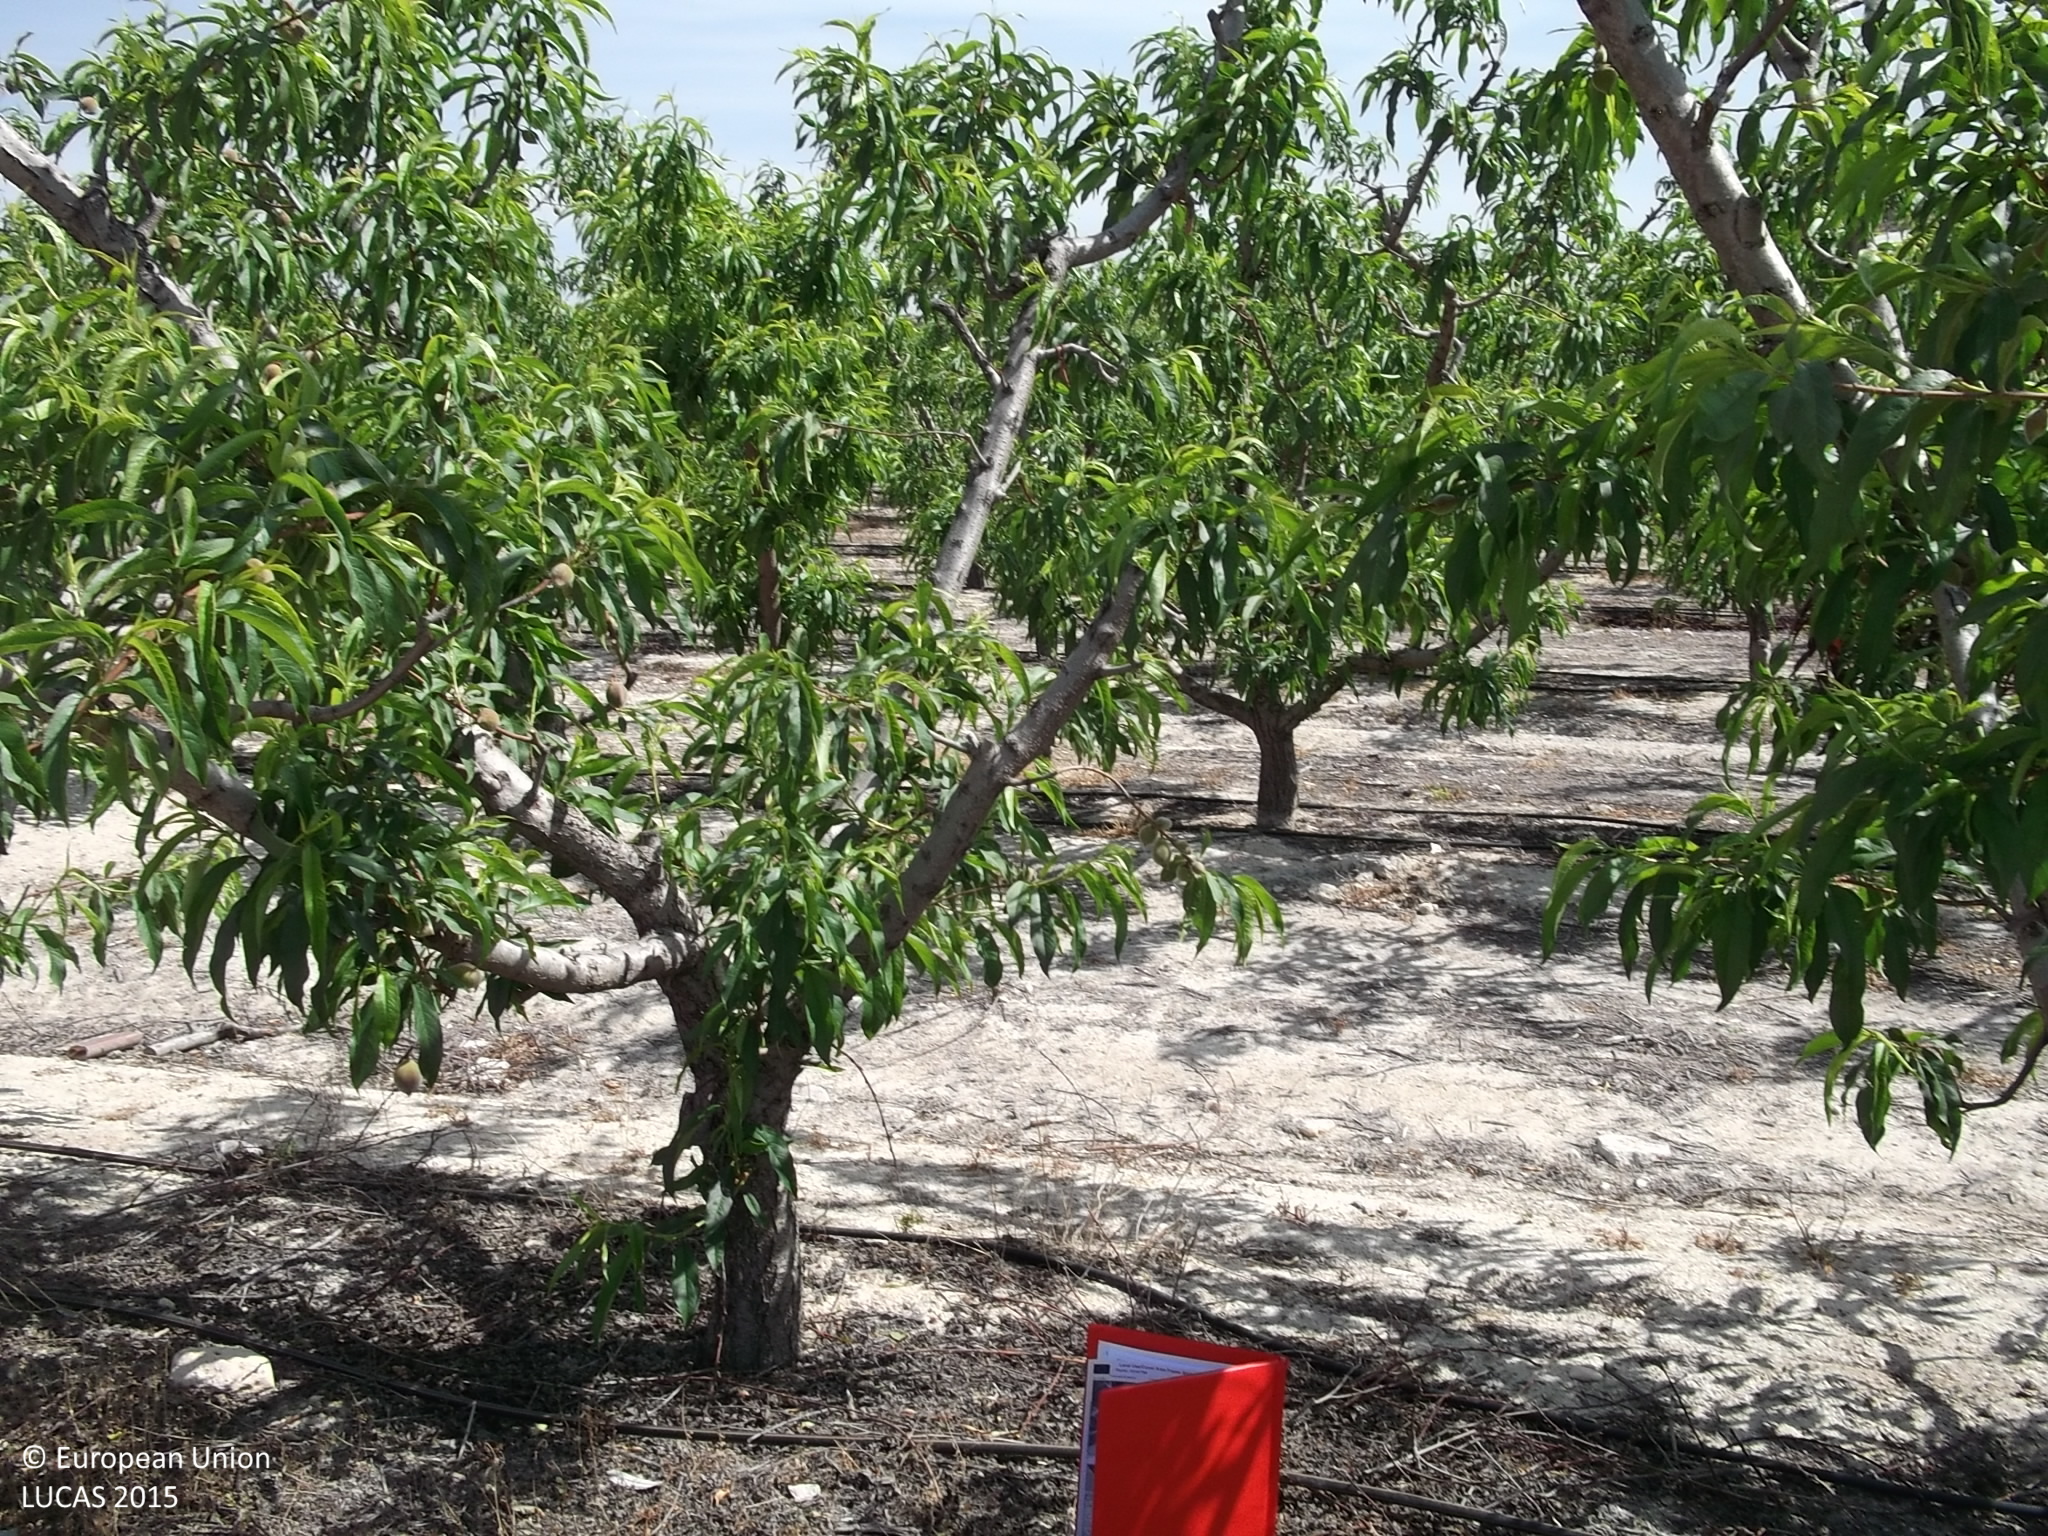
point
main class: Cropland
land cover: Other fruit trees and berries
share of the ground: 25 - 50 %
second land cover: Spontaneously vegetated surfaces
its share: 25 - 50 %
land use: Agriculture (excluding fallow land and kitchen gardens)
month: April
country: ES
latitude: 38.2759
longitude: -1.4773
